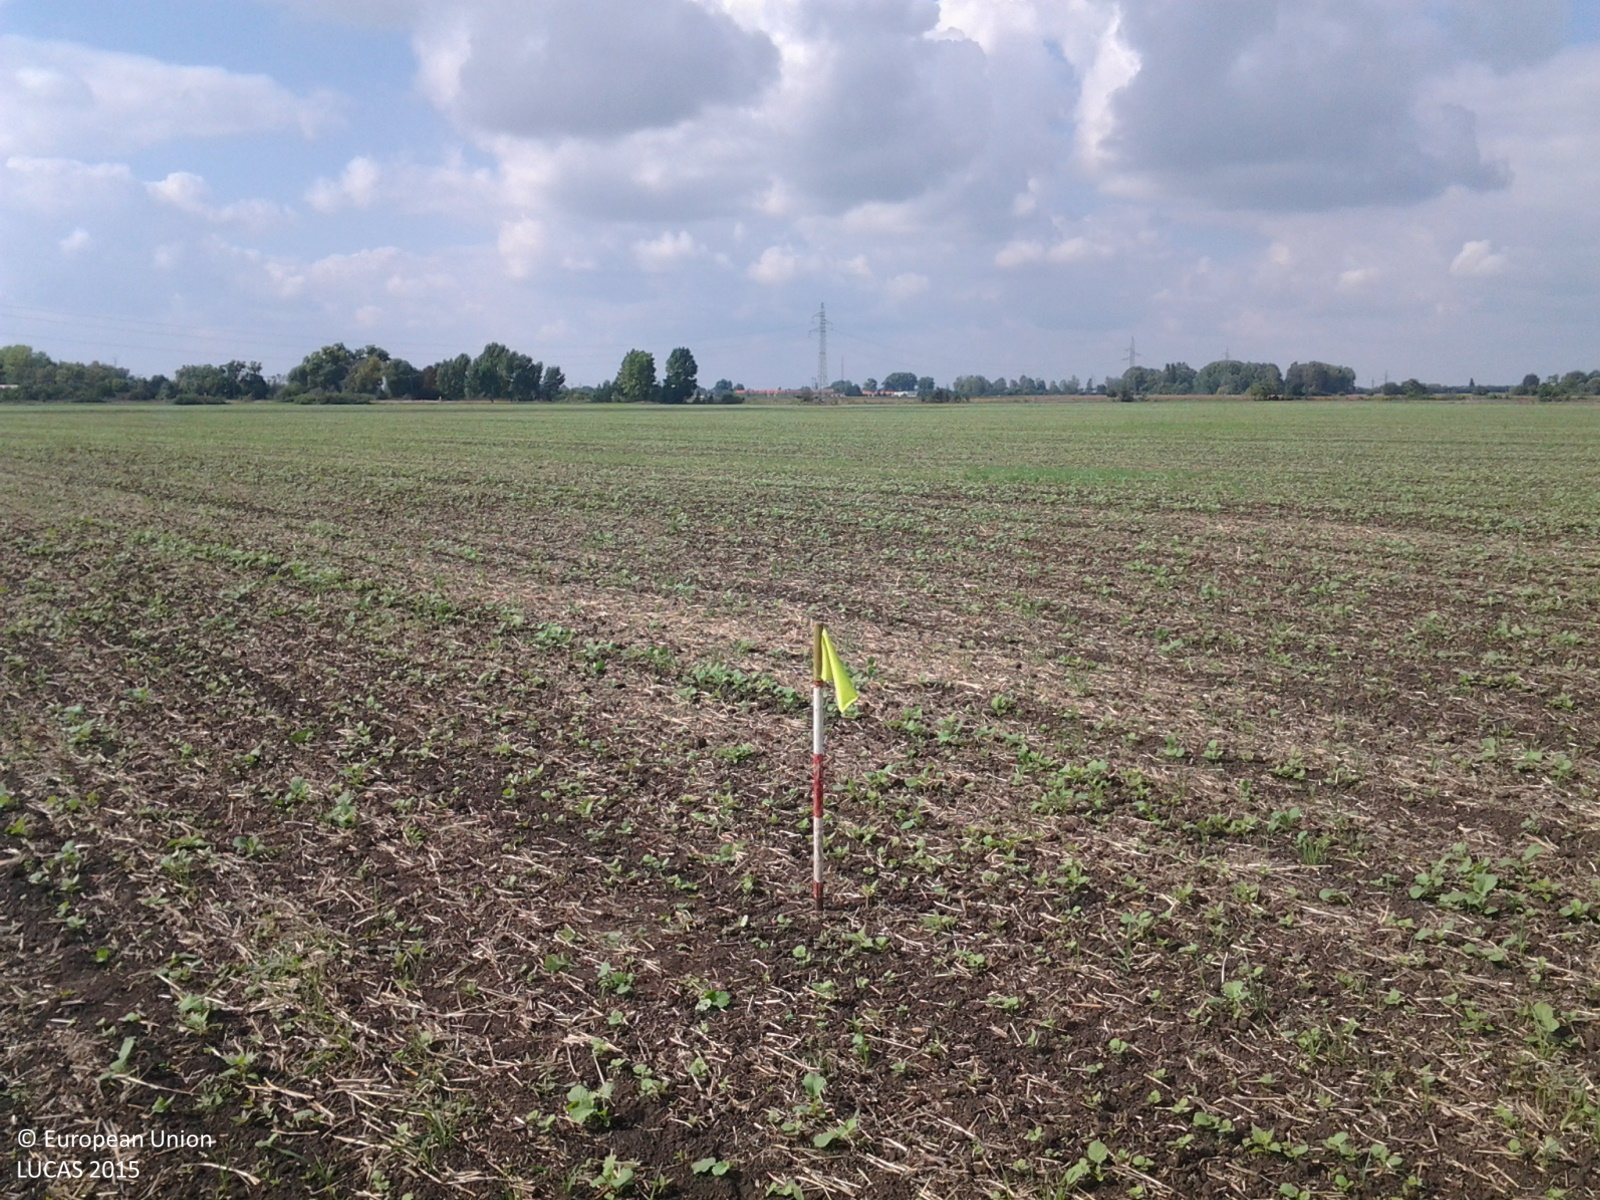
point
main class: Cropland
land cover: Rape and turnip rape
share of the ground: 25 - 50 %
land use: Agriculture (excluding fallow land and kitchen gardens)
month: September
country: HU
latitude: 47.6116
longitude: 20.3130
